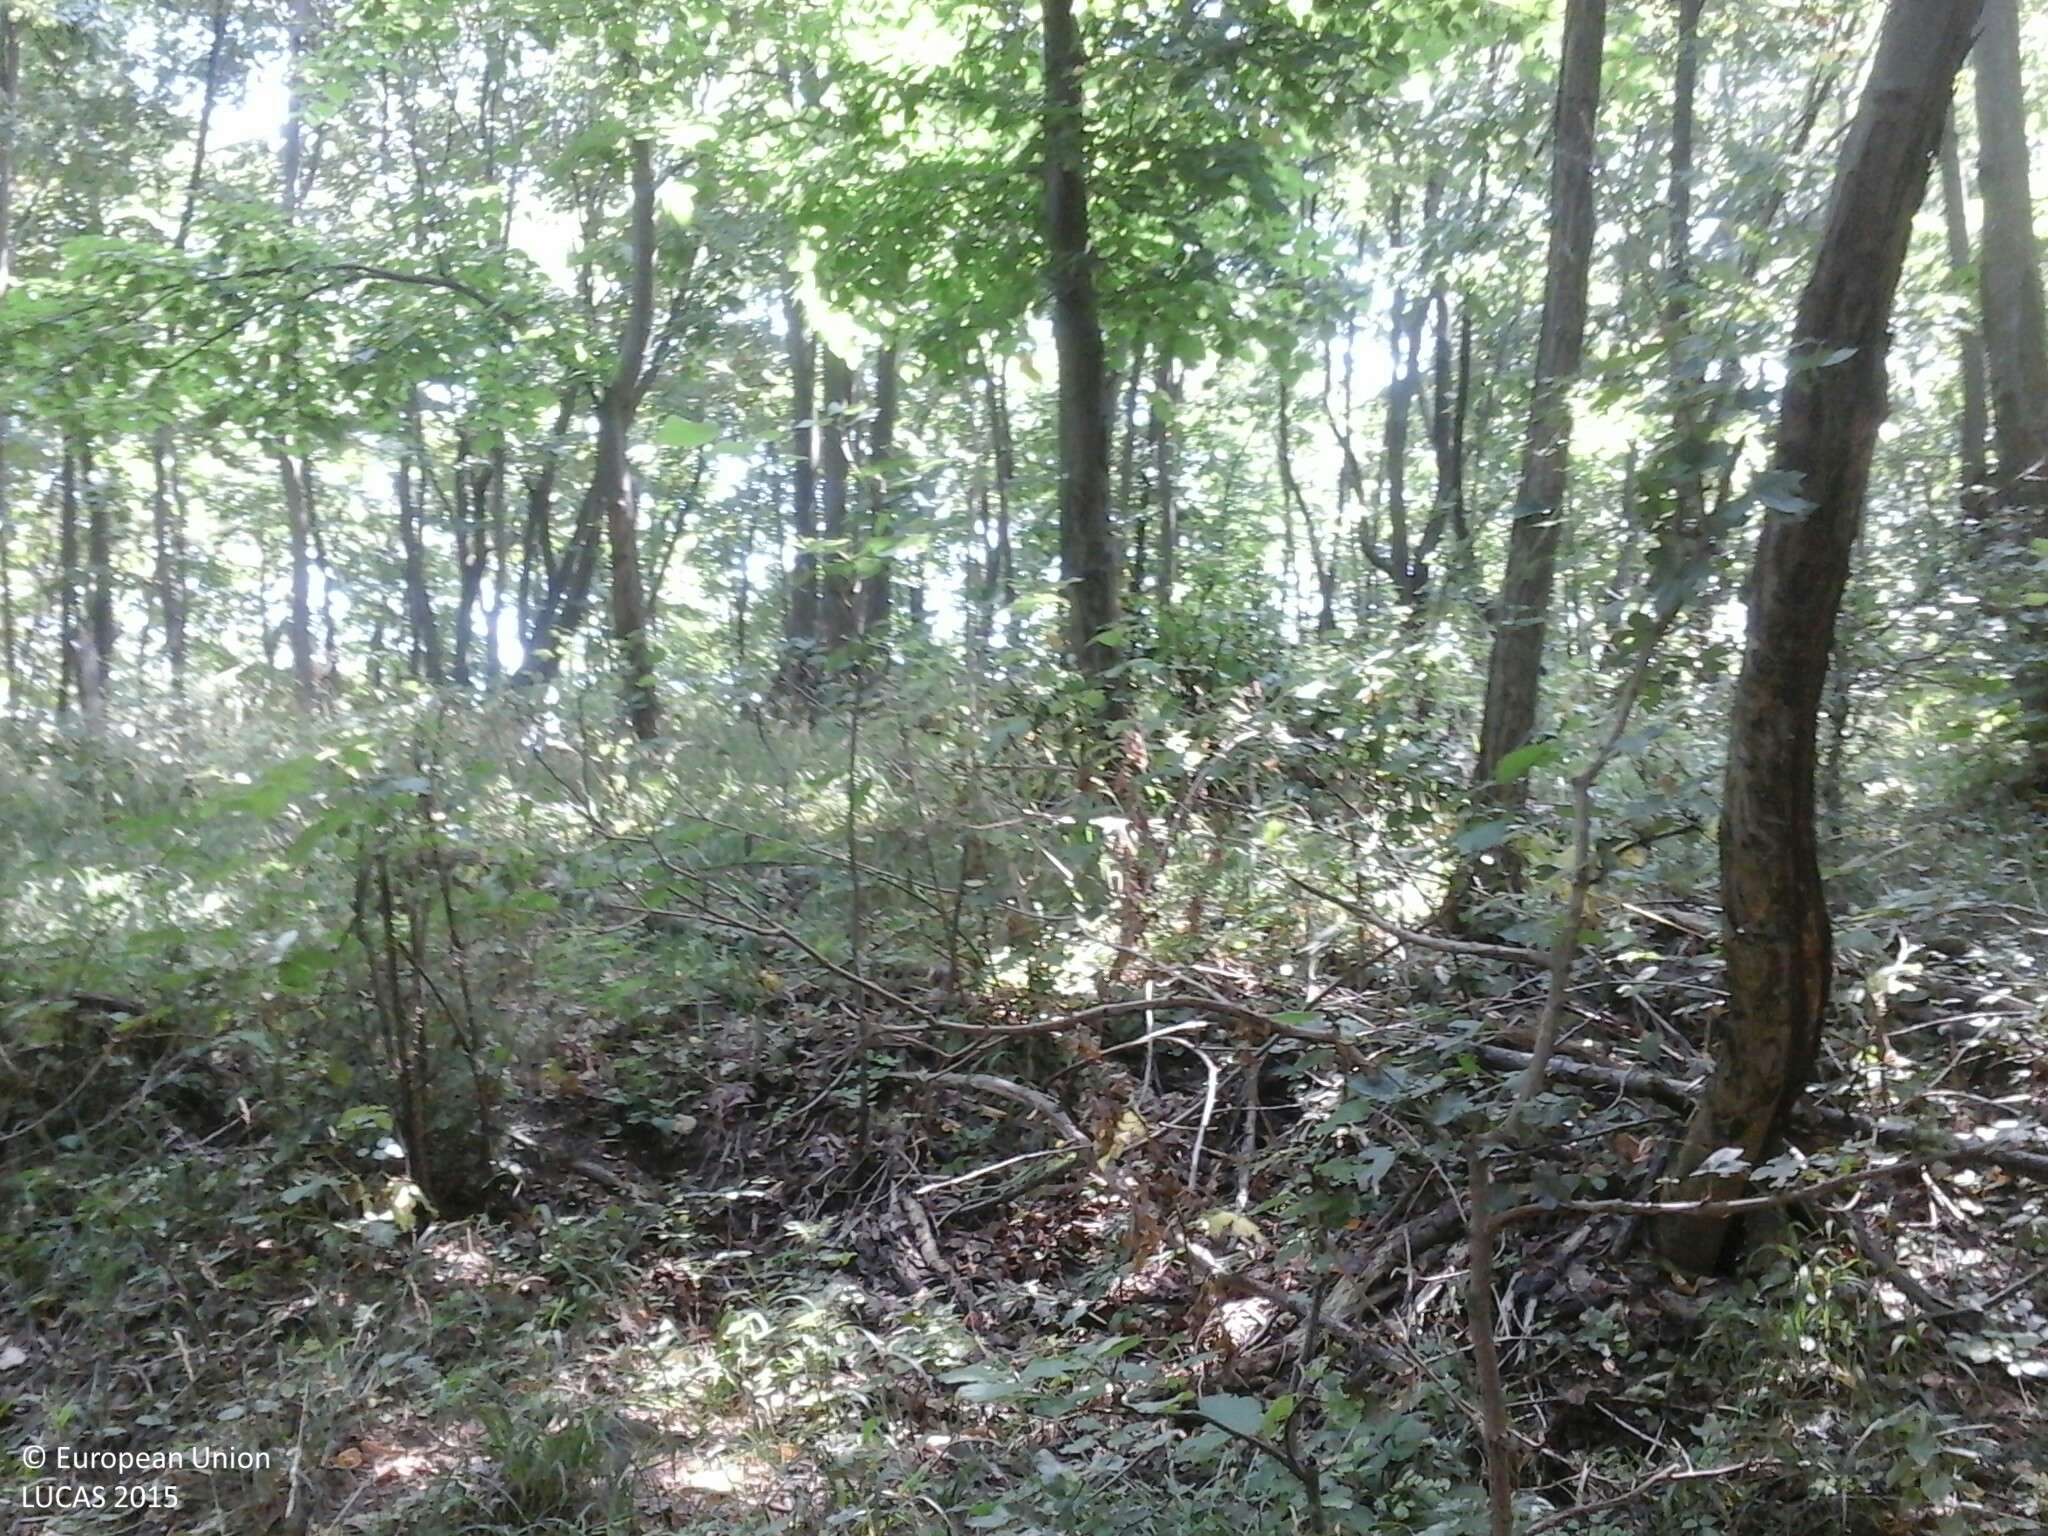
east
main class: Woodland
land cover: Broadleaved woodland
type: mesophytic deciduous forest
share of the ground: > 75 %
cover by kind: broadleaved forest trees 95 %, herbaceous plants 5 %
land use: Forestry
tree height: > 5 m
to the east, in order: Broadleaved woodland; Ditches and canals; Broadleaved woodland; Grass margins; Paved roads, cycling and walking lanes; Grass margins; Broadleaved woodland
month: August
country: HU
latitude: 46.8337
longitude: 17.9401
